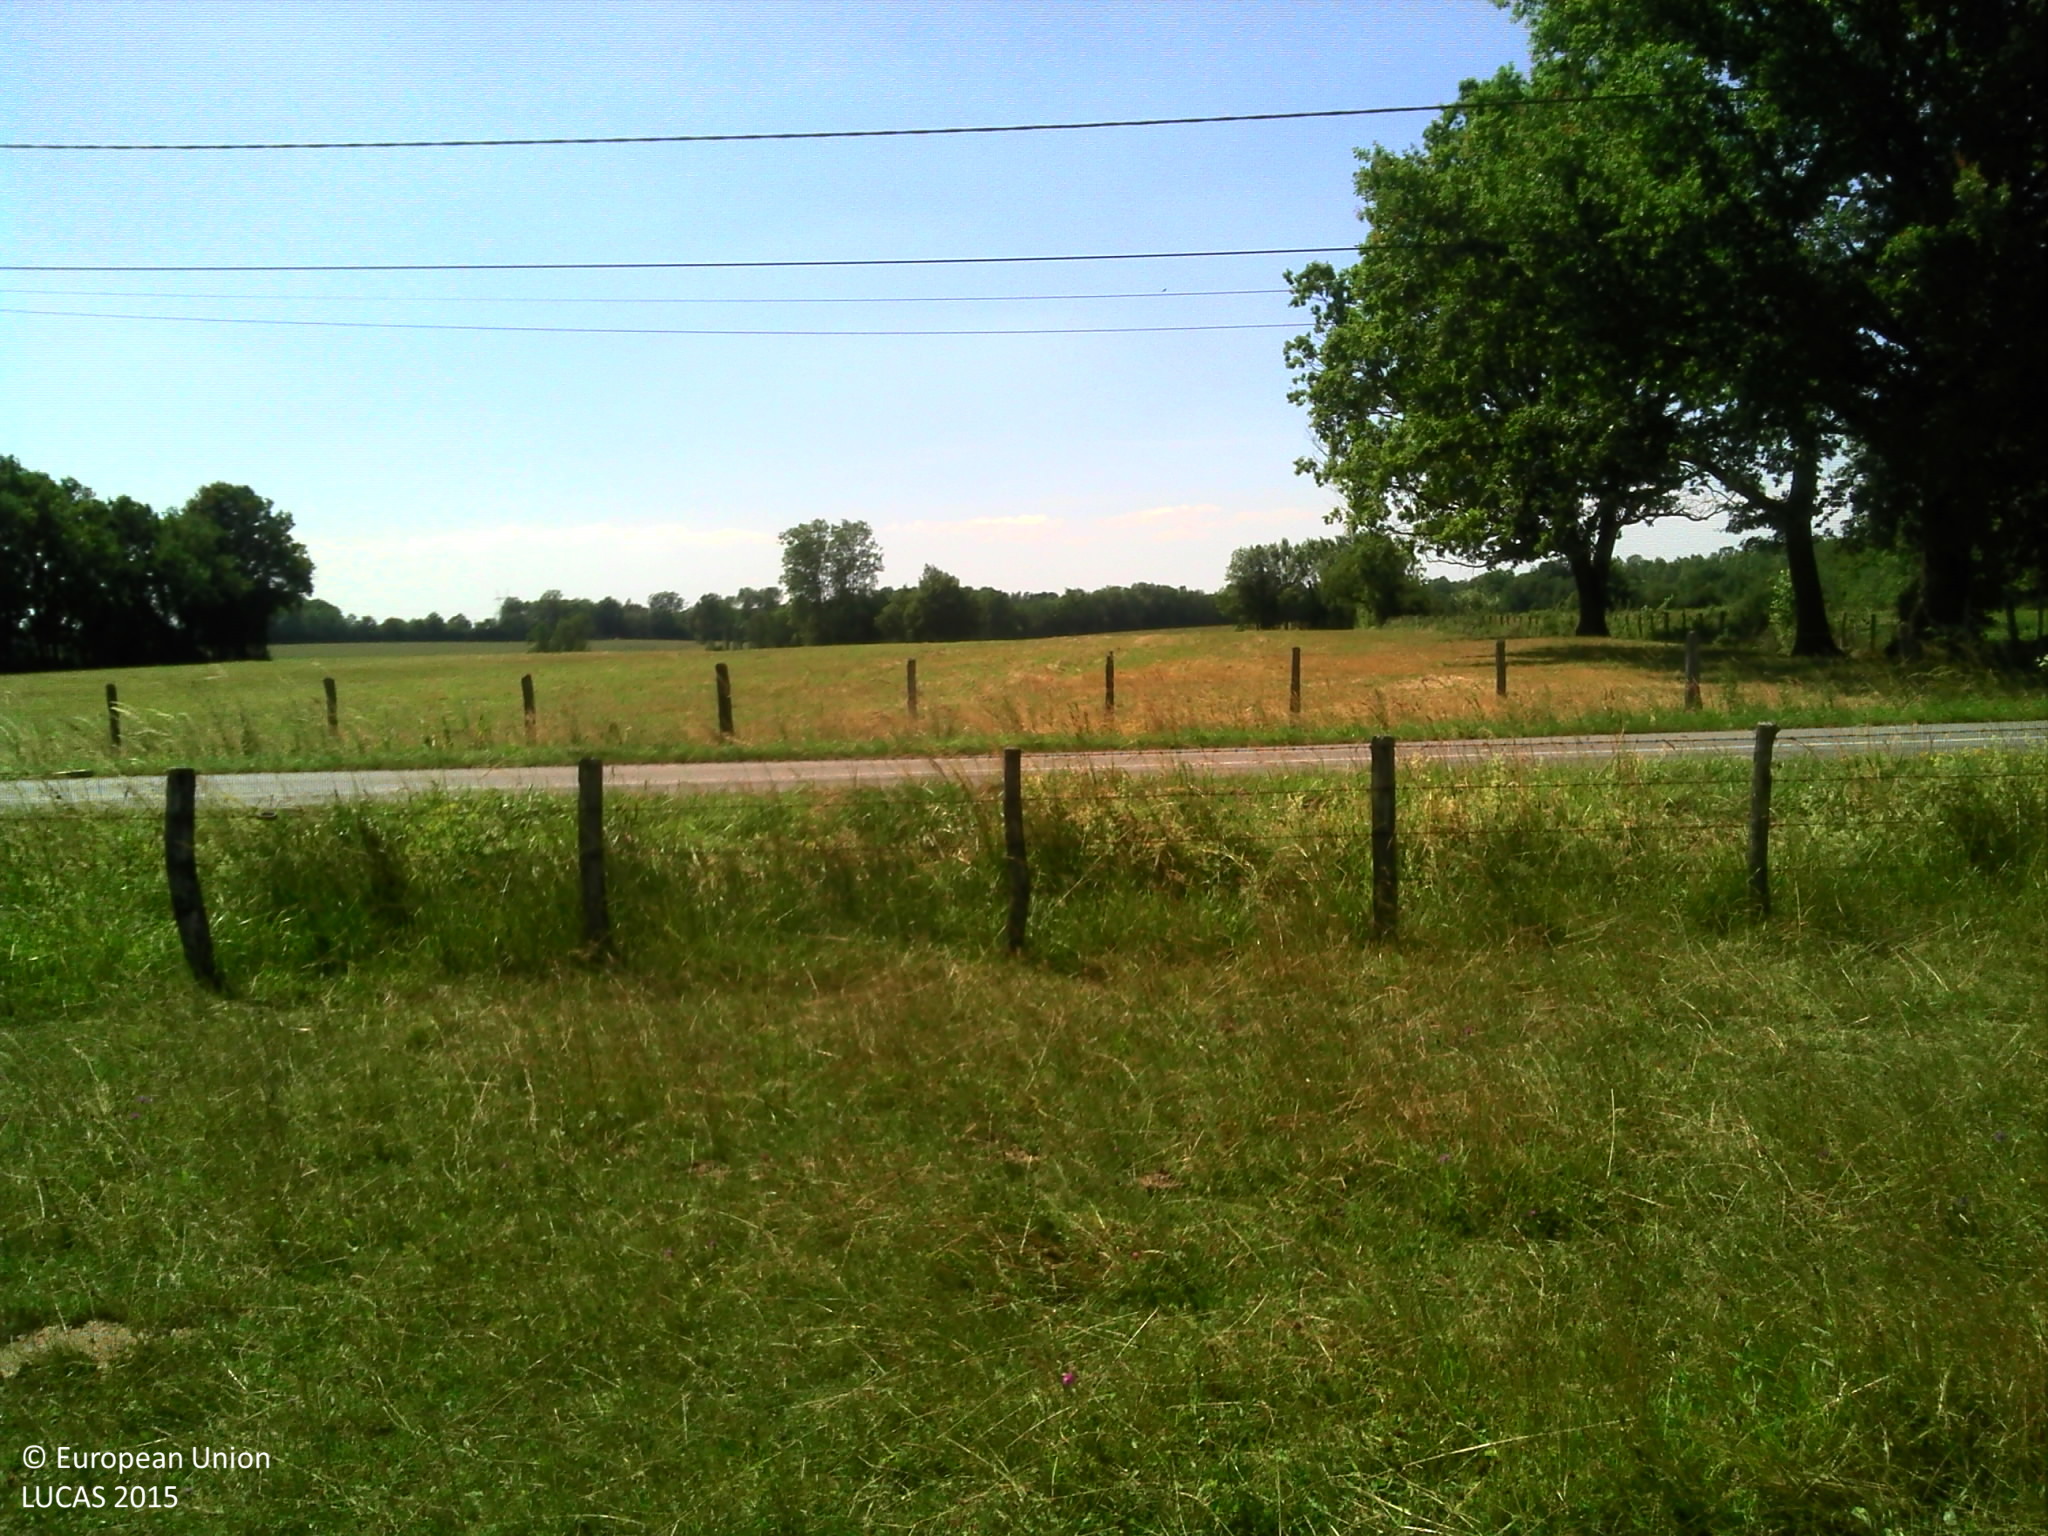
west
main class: Grassland
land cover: Grassland without tree/shrub cover
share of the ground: > 75 %
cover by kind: herbaceous plants 100 %
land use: Agriculture (excluding fallow land and kitchen gardens)
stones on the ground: < 10 %
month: June
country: FR
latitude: 46.7329
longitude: 5.2517
